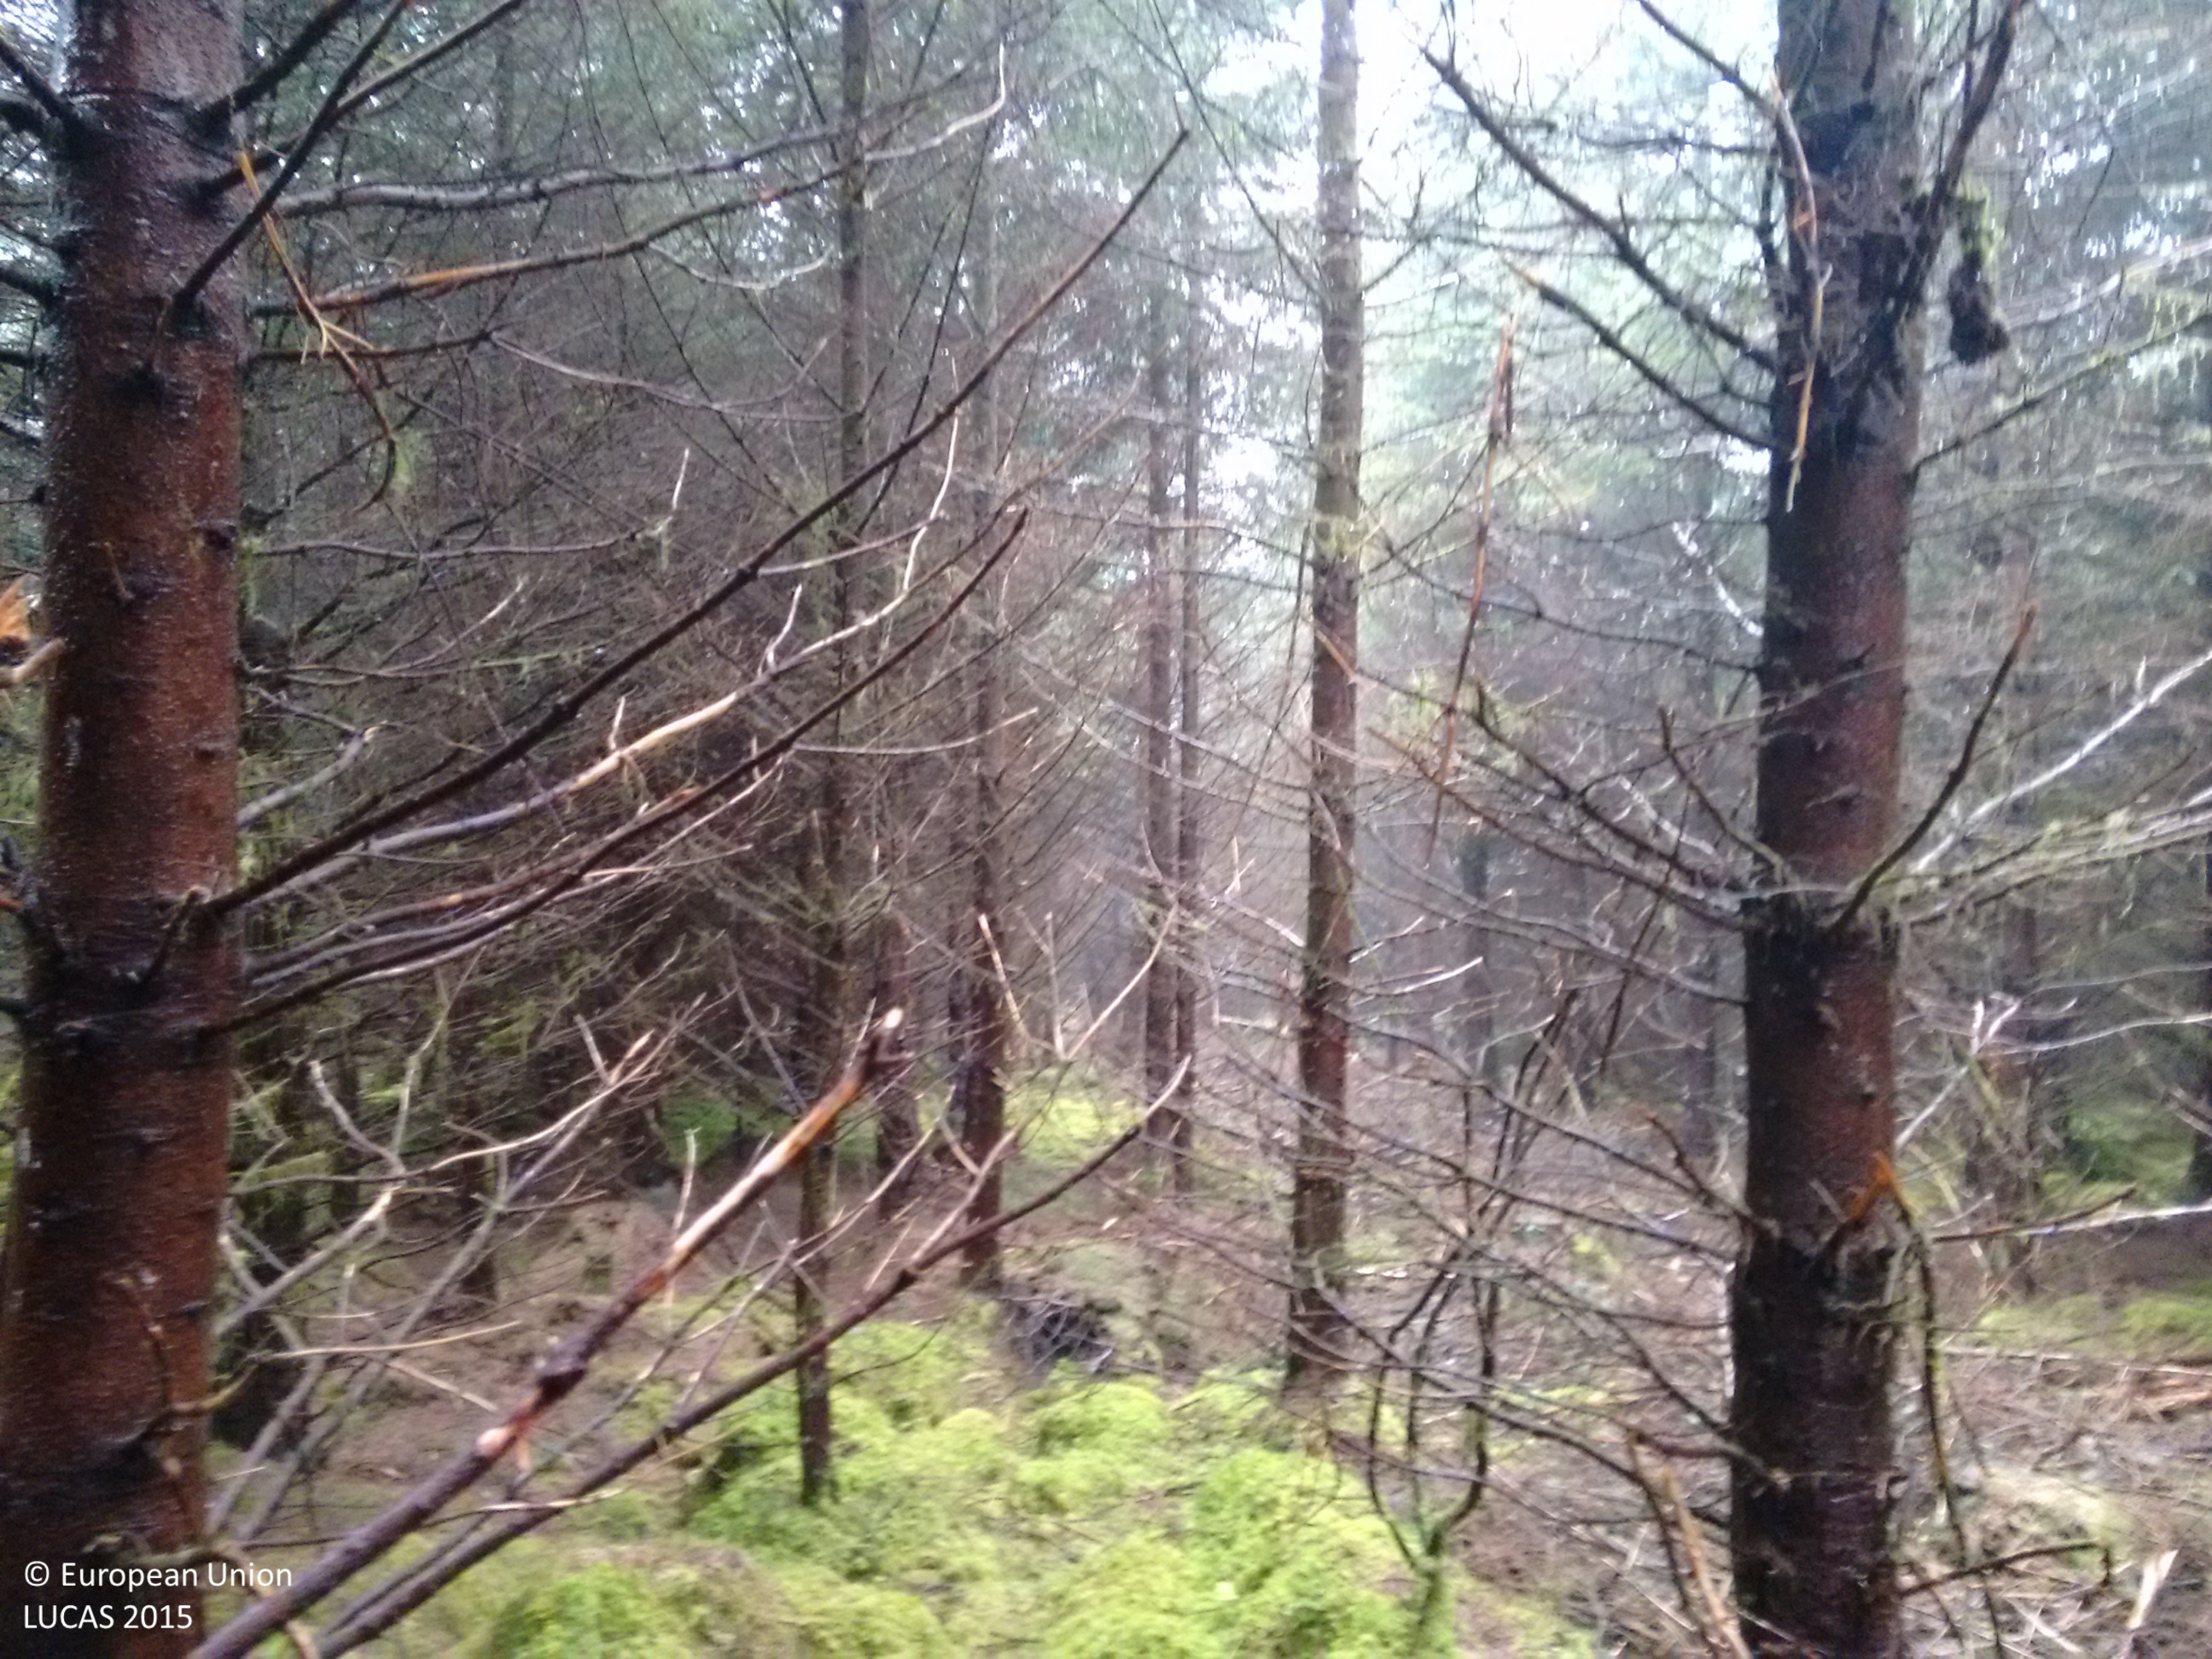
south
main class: Woodland
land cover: Spruce dominated coniferous woodland
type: exotic forest
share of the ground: > 75 %
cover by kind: coniferous forest trees 80 %, lichens and mosses 20 %
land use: Forestry
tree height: > 5 m
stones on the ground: < 10 %
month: November
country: IE
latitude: 54.3257
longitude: -8.1216
